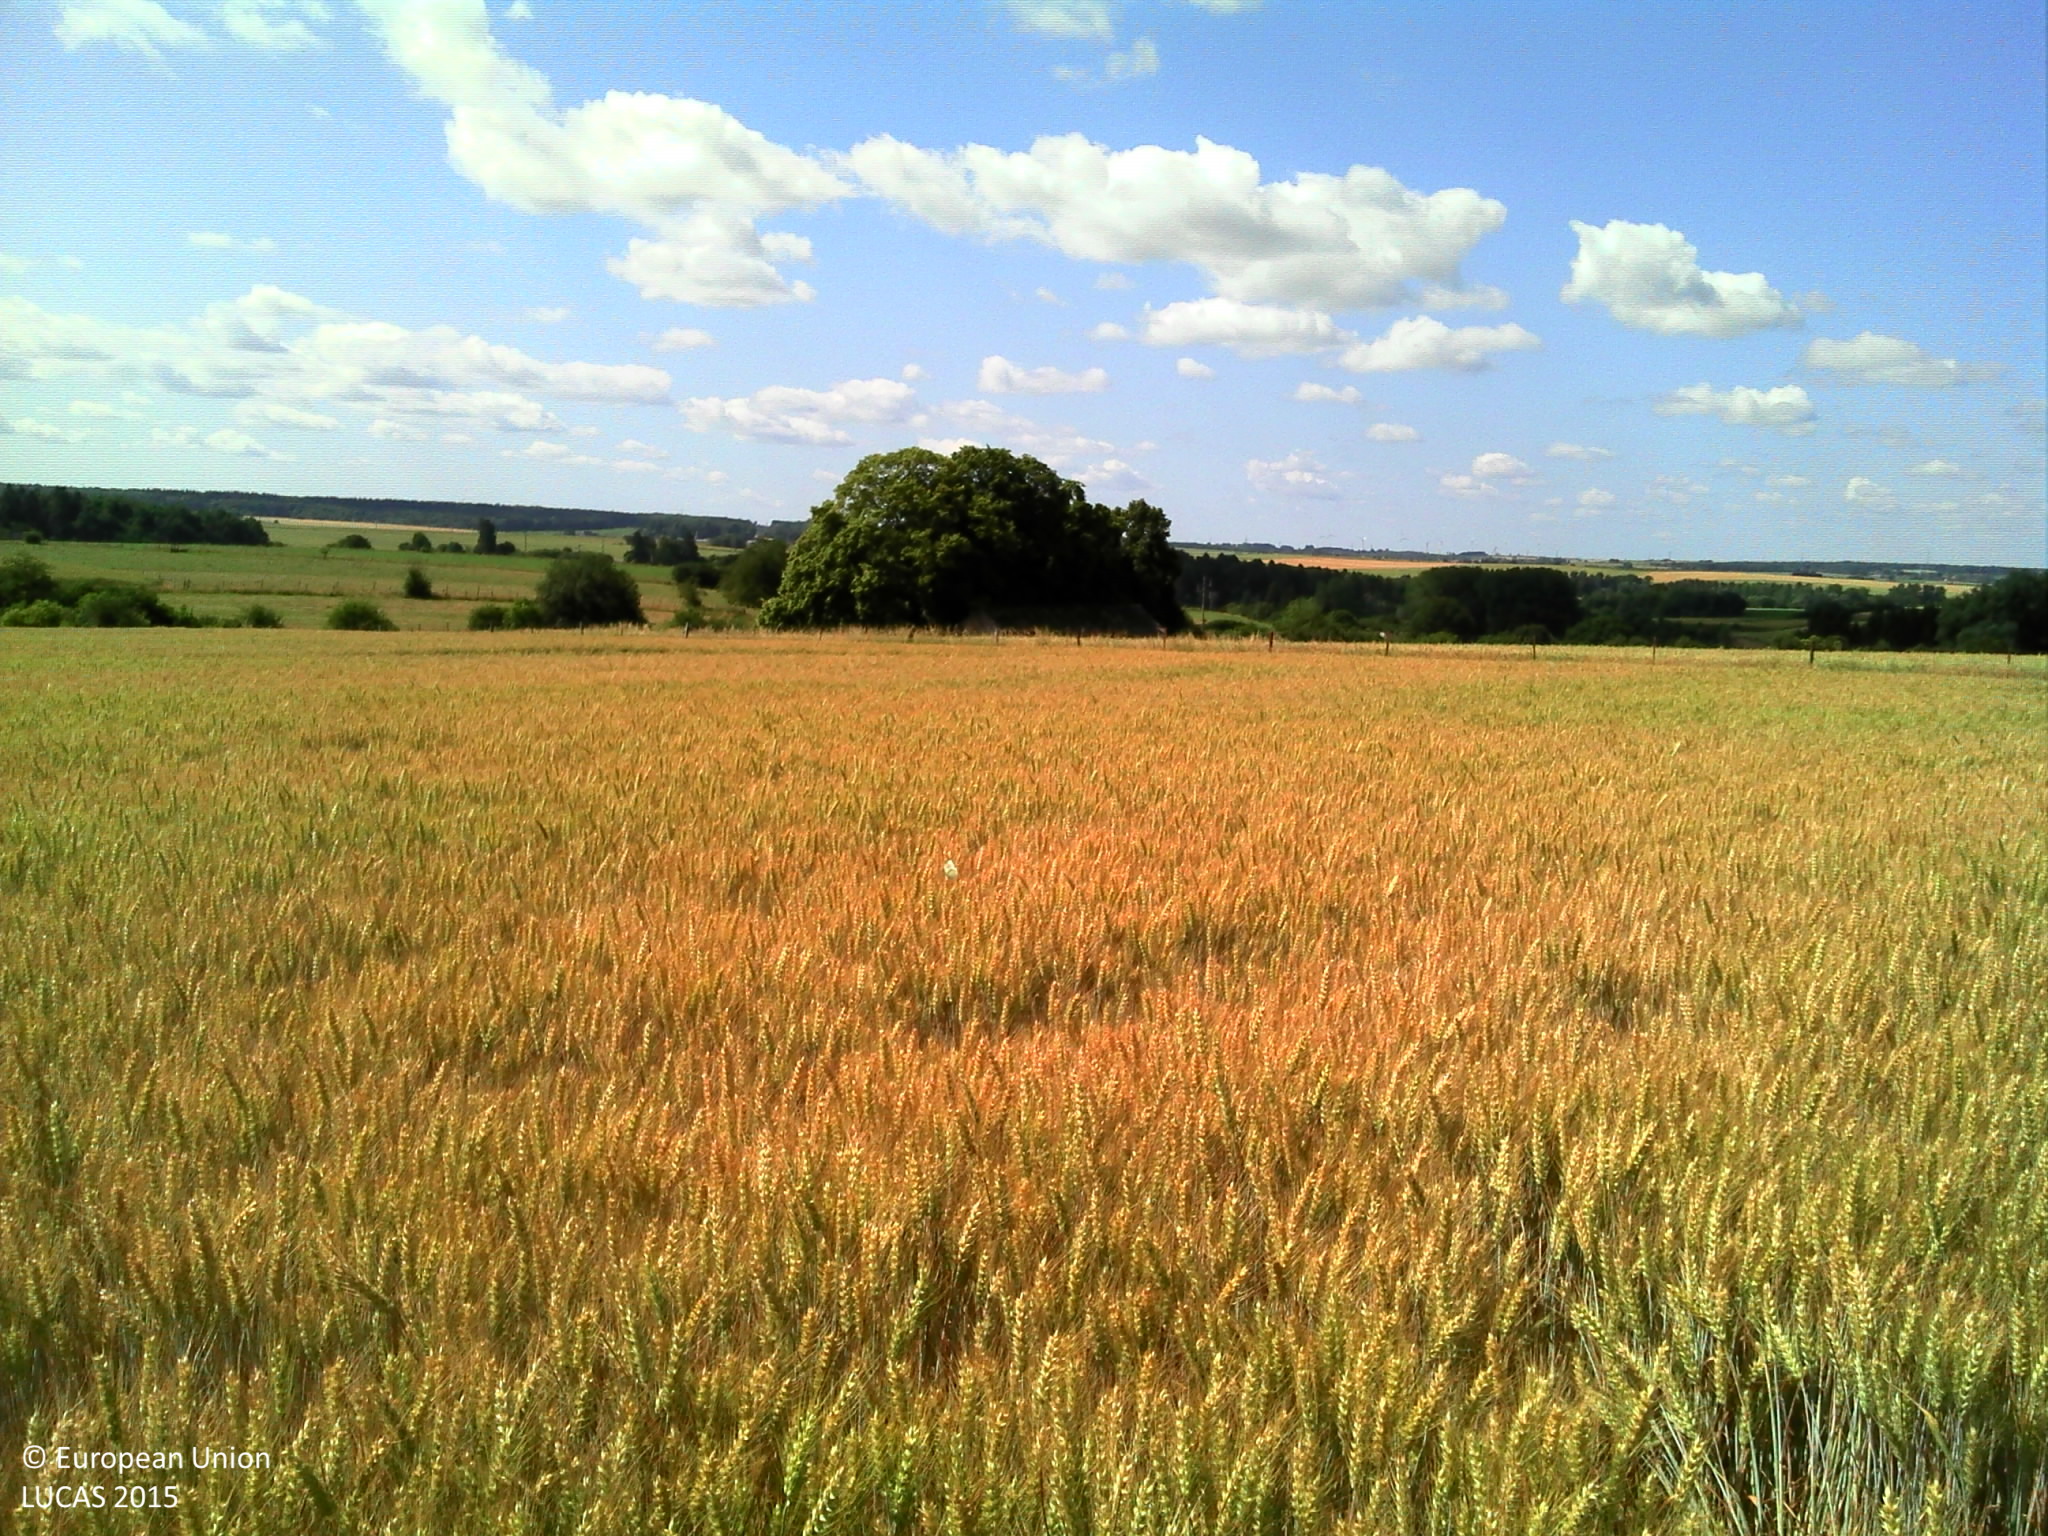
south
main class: Cropland
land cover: Common wheat
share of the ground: > 75 %
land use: Agriculture (excluding fallow land and kitchen gardens)
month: July
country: BE
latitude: 50.2531
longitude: 4.5684
